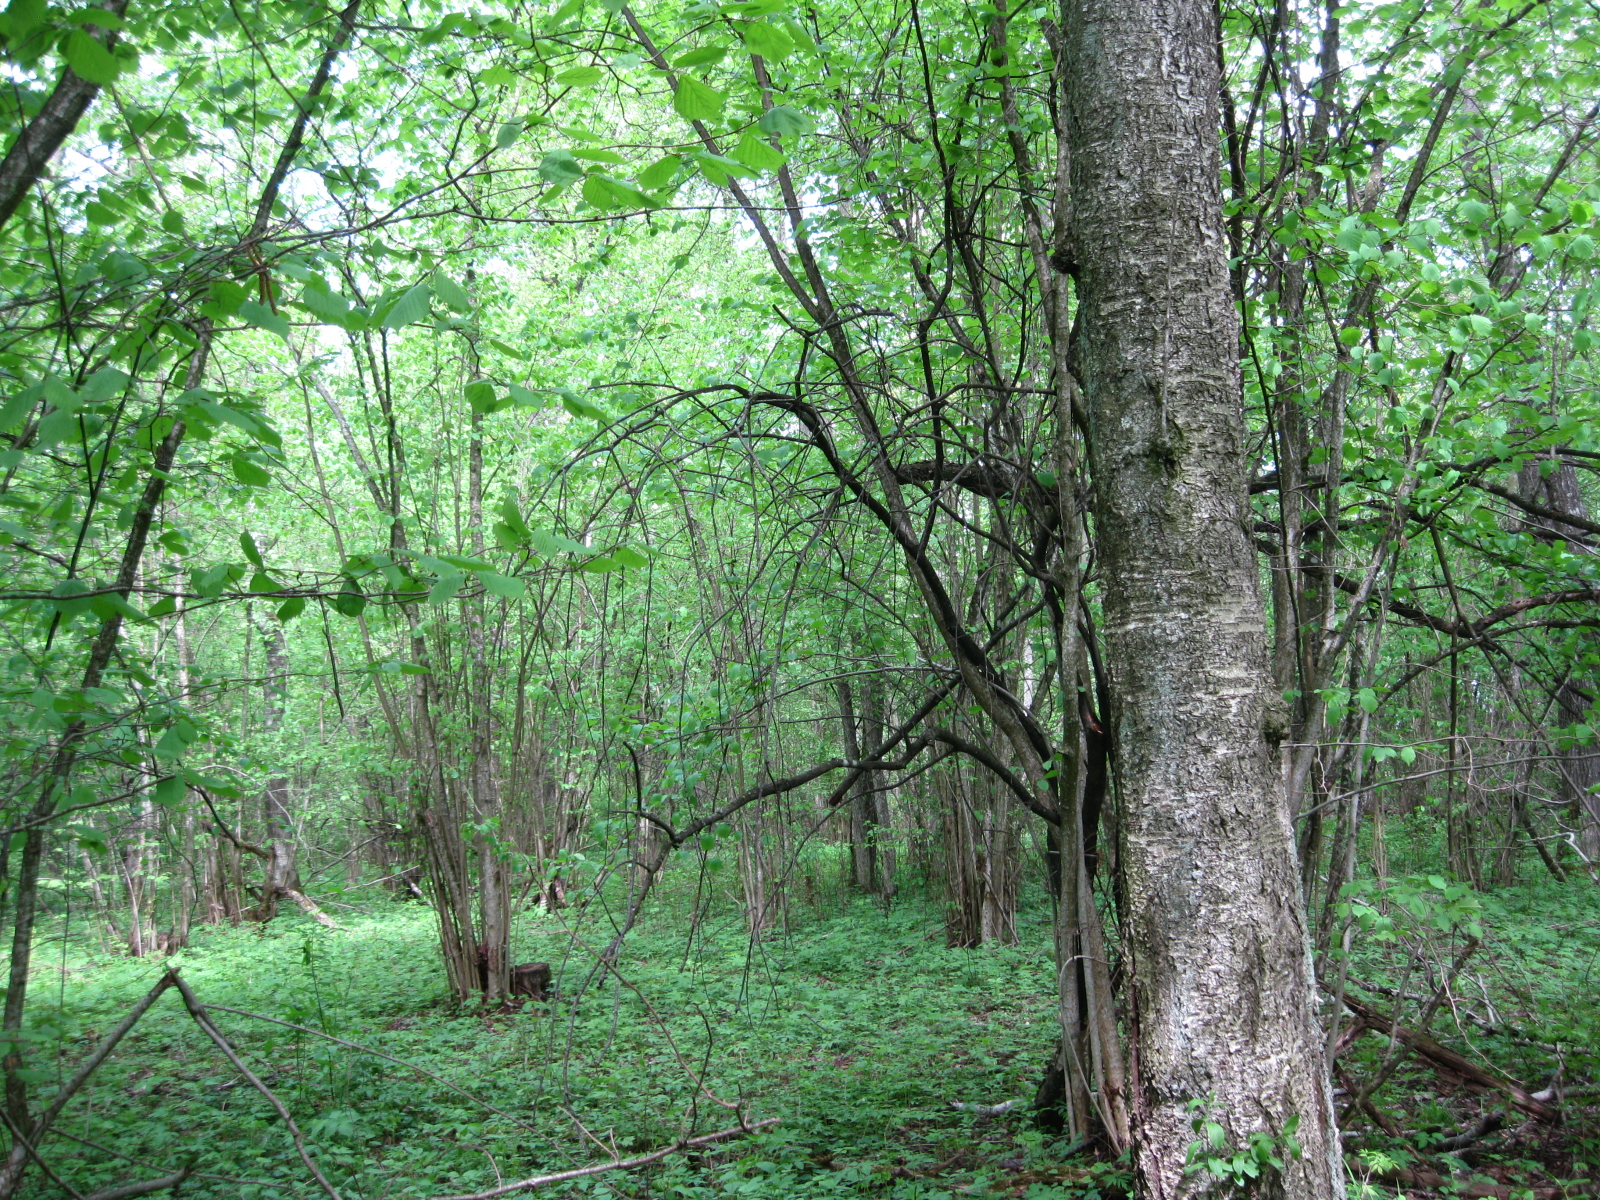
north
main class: Woodland
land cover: Broadleaved woodland
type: non-riverine alder, birch or aspen forest
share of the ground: > 75 %
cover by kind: broadleaved forest trees 85 %, shrubs 5 %, herbaceous plants 5 %, unconsolidated bare surface 5 %
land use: Forestry
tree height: > 5 m
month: May
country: LT
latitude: 56.2261
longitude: 24.2696
